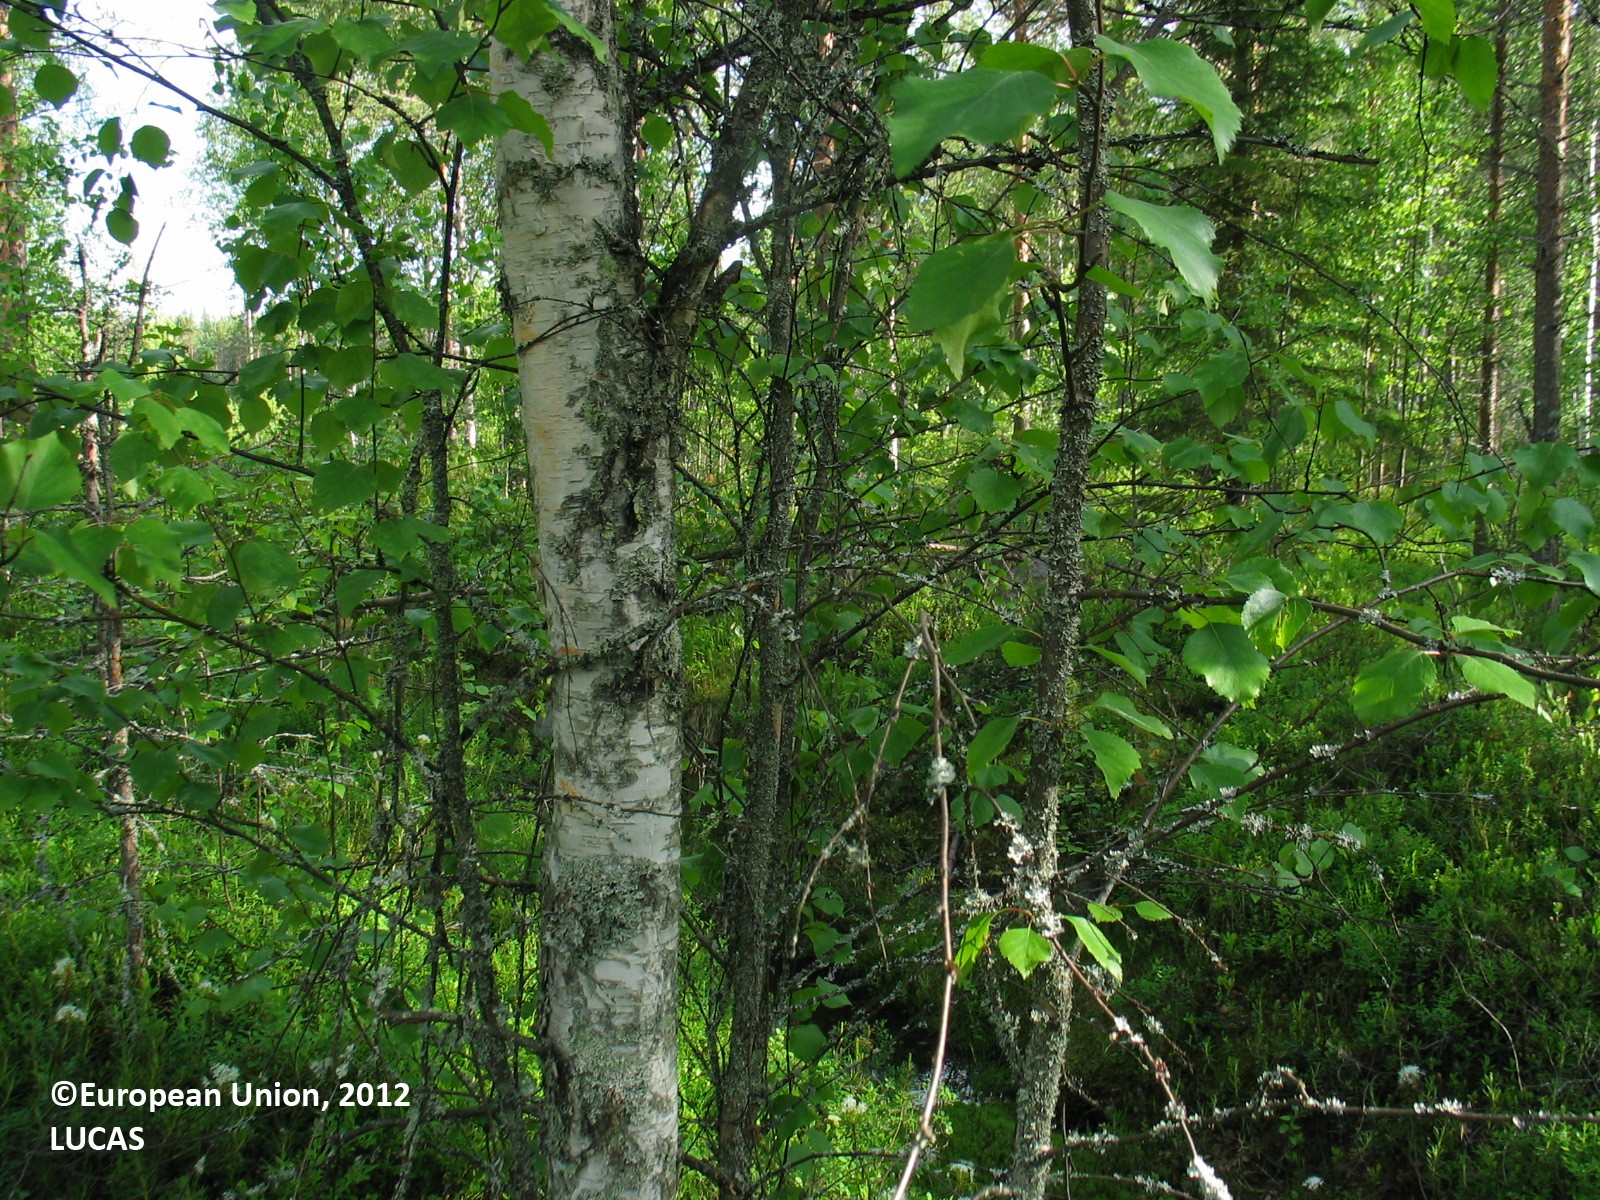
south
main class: Woodland
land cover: Pine dominated mixed woodland
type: boreal forest
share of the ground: 50 - 75 %
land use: Forestry
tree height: > 5 m
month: June
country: FI
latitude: 64.8044
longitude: 26.6842
